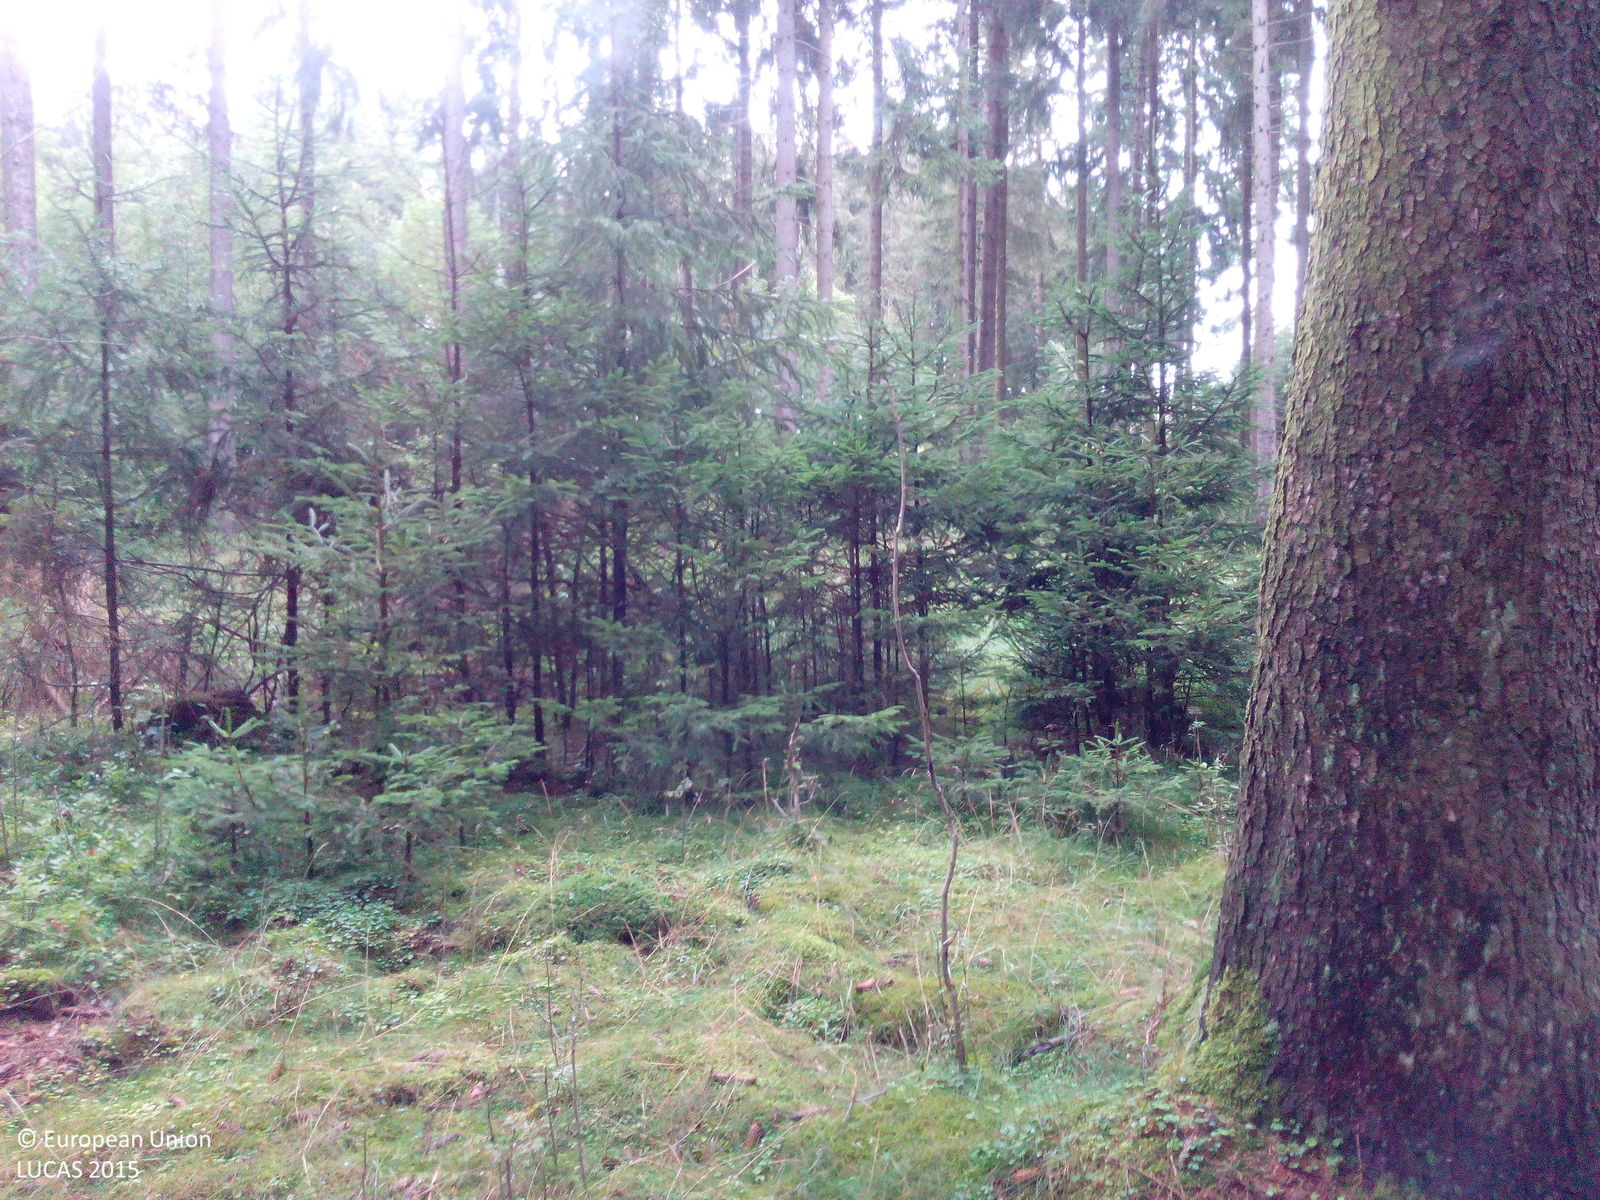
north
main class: Woodland
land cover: Spruce dominated coniferous woodland
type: hemiboreal forest and nemoral coniferous forest and mixed broadleaved-coniferous forest
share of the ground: > 75 %
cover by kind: coniferous forest trees 90 %, herbaceous plants 10 %
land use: Forestry
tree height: > 5 m
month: August
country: DE
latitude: 51.7107
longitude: 10.6221
